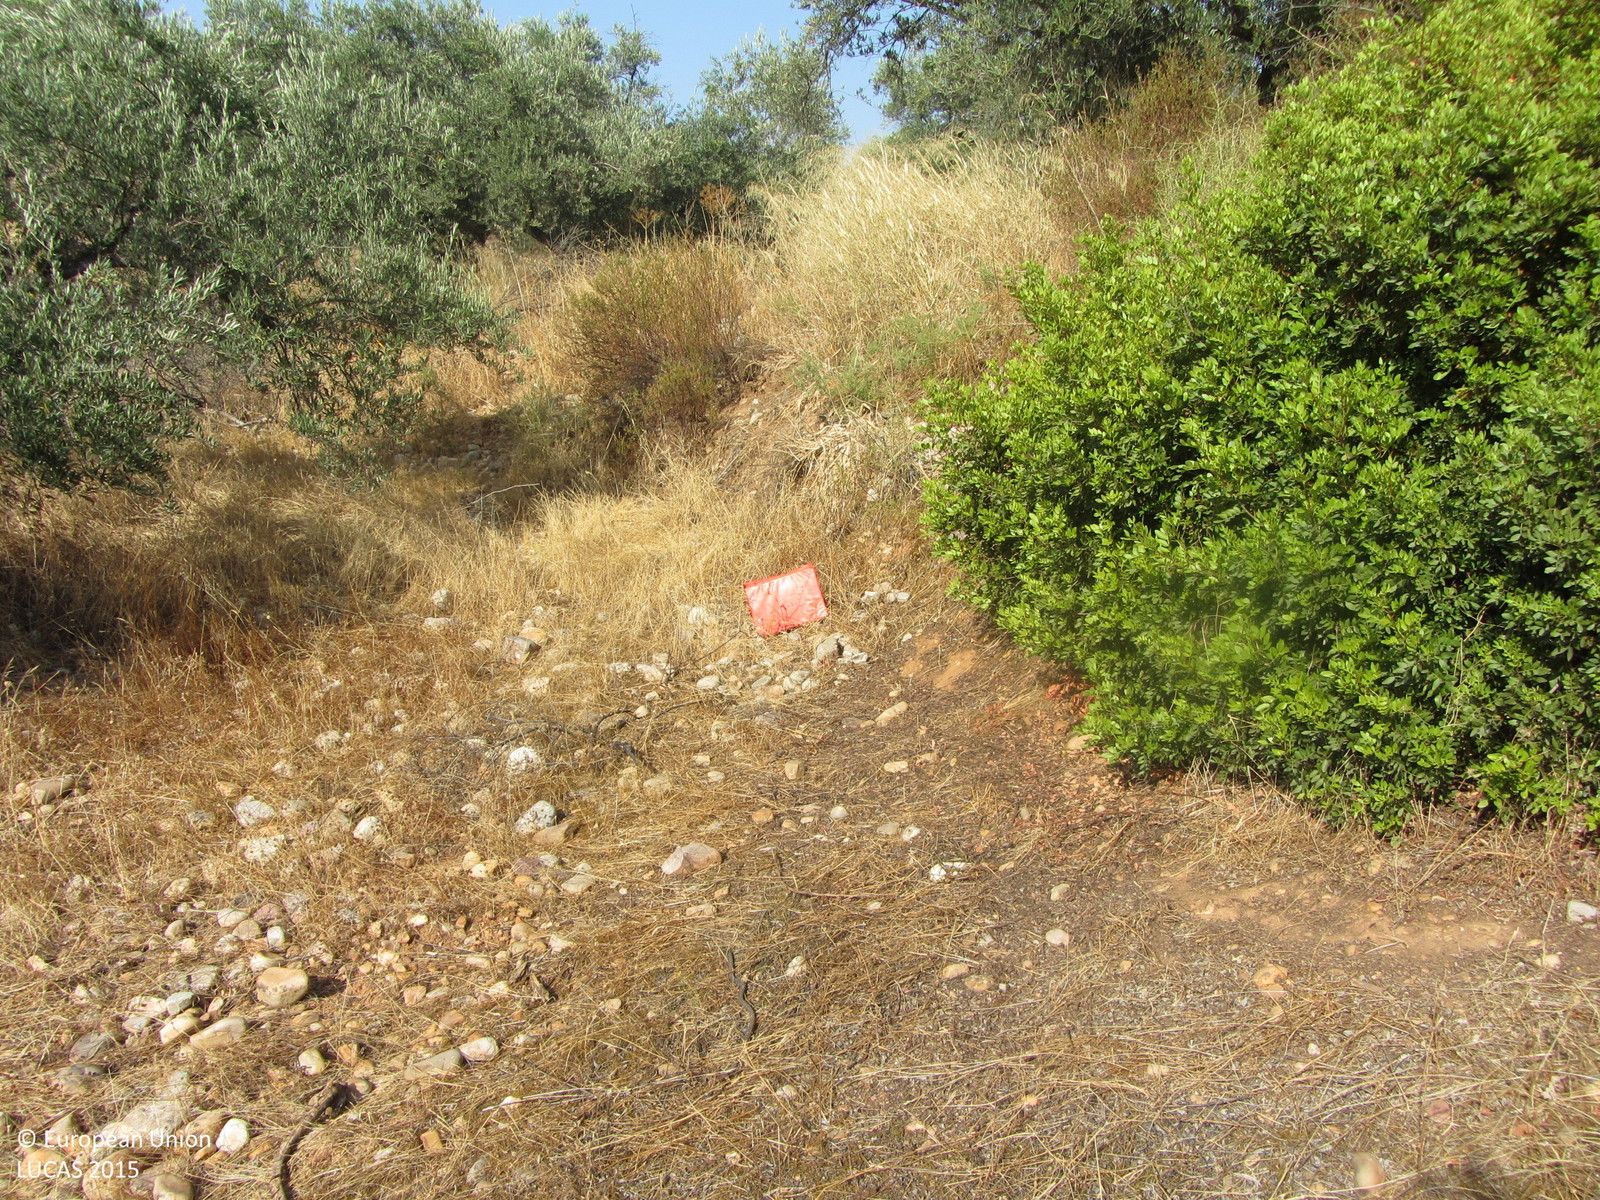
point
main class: Cropland
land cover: Olive groves
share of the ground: 25 - 50 %
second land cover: Spontaneously vegetated surfaces
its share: 50 - 75 %
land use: Agriculture (excluding fallow land and kitchen gardens)
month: July
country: ES
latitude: 38.0506
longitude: -3.8515
